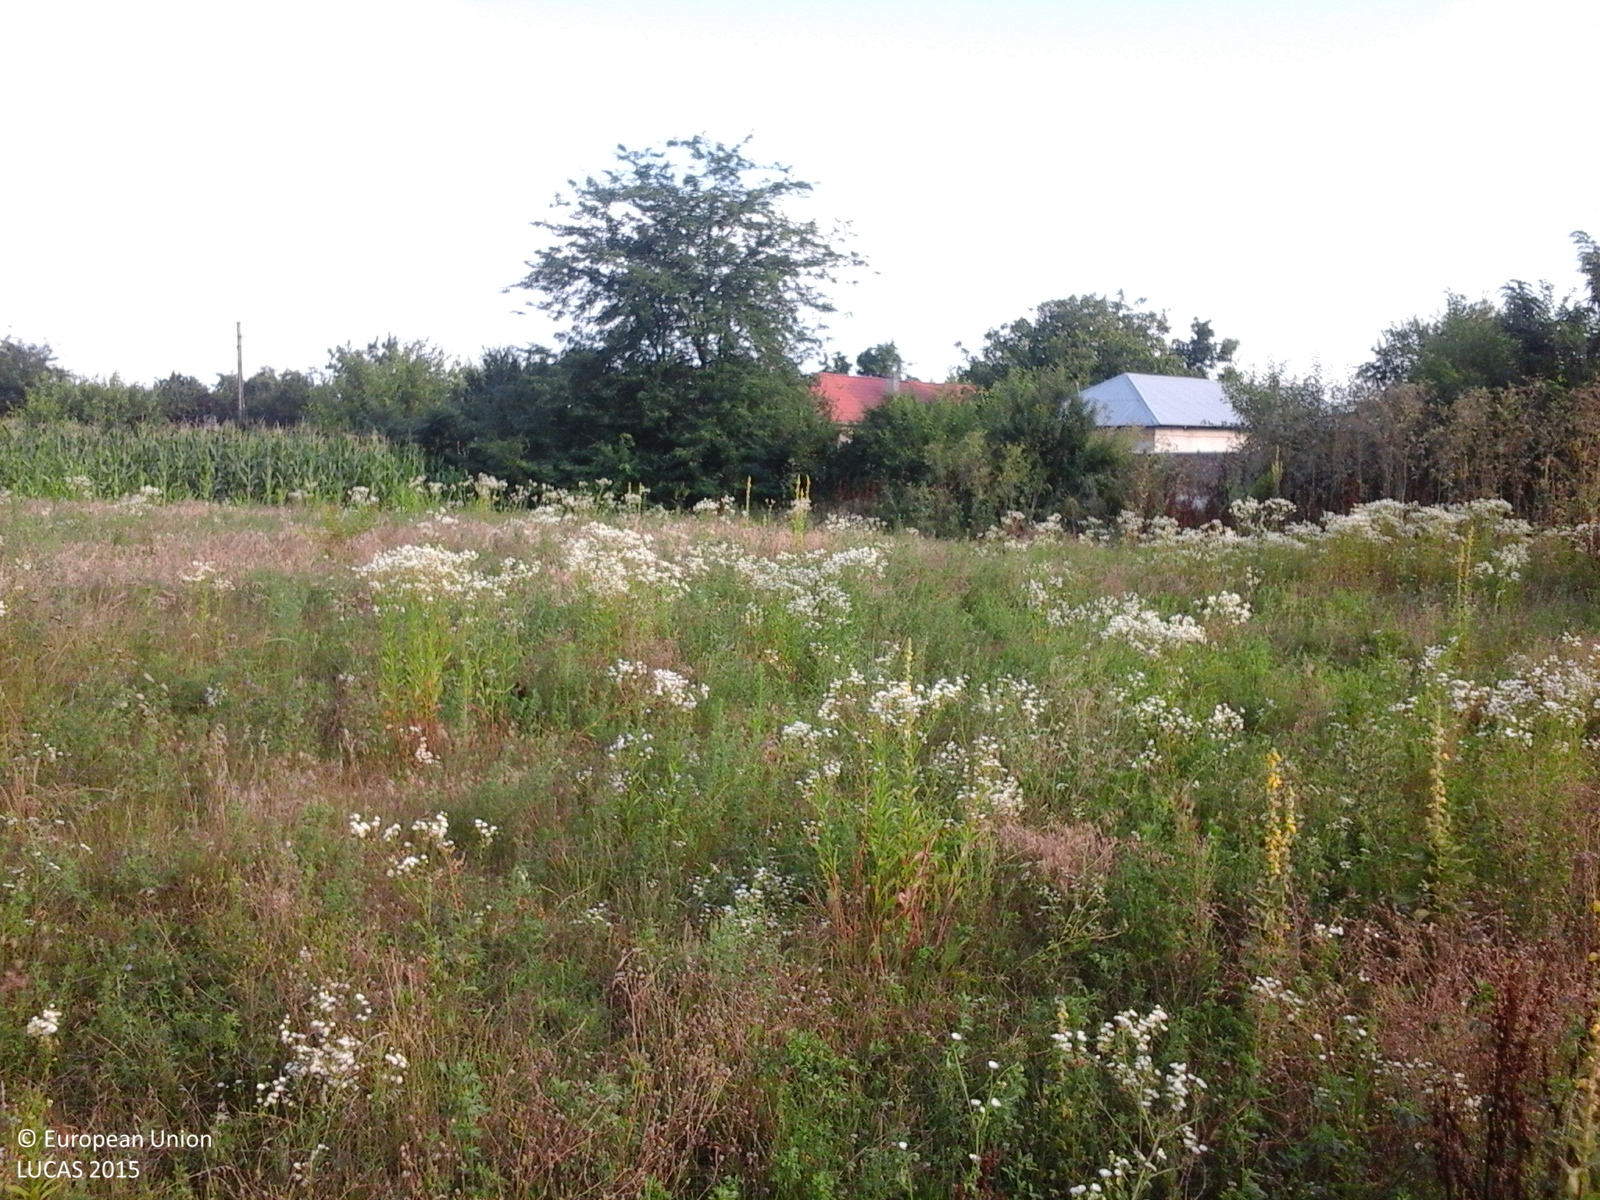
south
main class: Grassland
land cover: Spontaneously vegetated surfaces
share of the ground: > 75 %
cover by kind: herbaceous plants 100 %
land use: Agriculture (excluding fallow land and kitchen gardens)
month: July
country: RO
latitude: 44.1621
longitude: 24.4095
